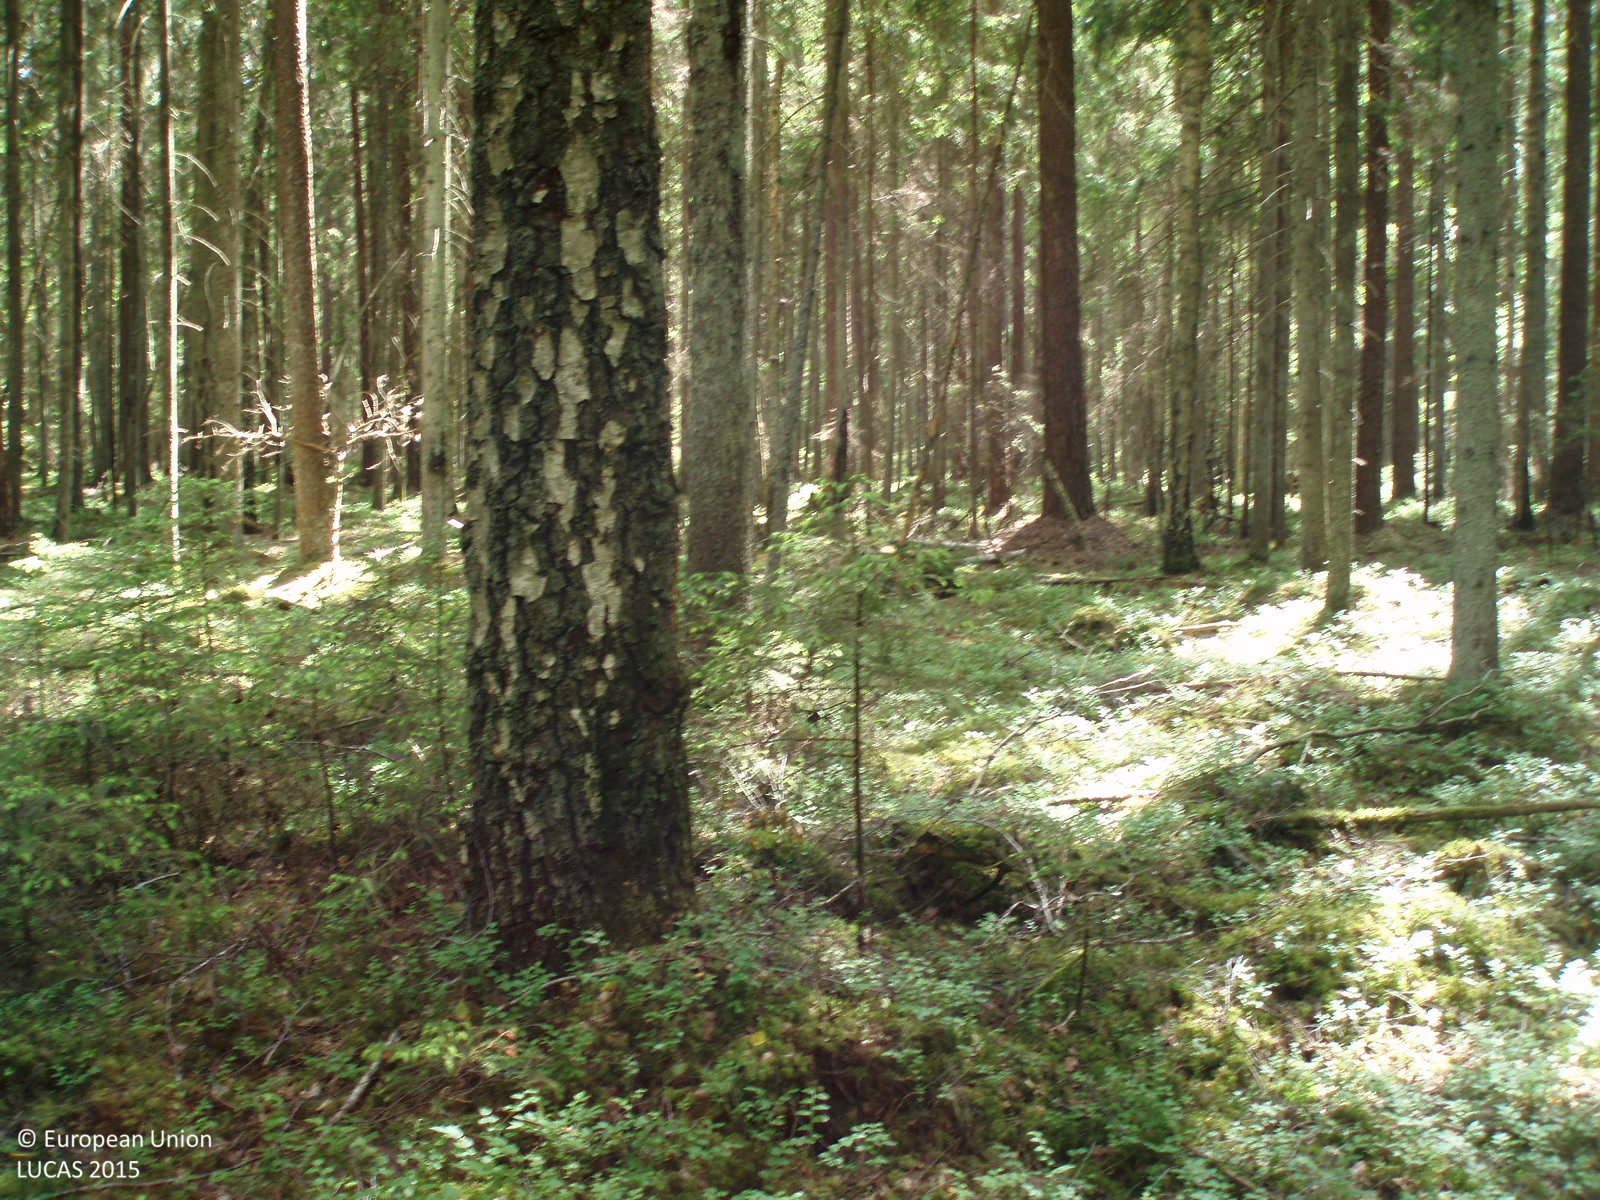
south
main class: Woodland
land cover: Spruce dominated coniferous woodland
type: hemiboreal forest and nemoral coniferous forest and mixed broadleaved-coniferous forest
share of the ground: > 75 %
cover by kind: coniferous forest trees 60 %, broadleaved forest trees 20 %, herbaceous plants 10 %, lichens and mosses 10 %
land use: Forestry
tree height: > 5 m
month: June
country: LT
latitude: 55.1570
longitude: 22.4760
